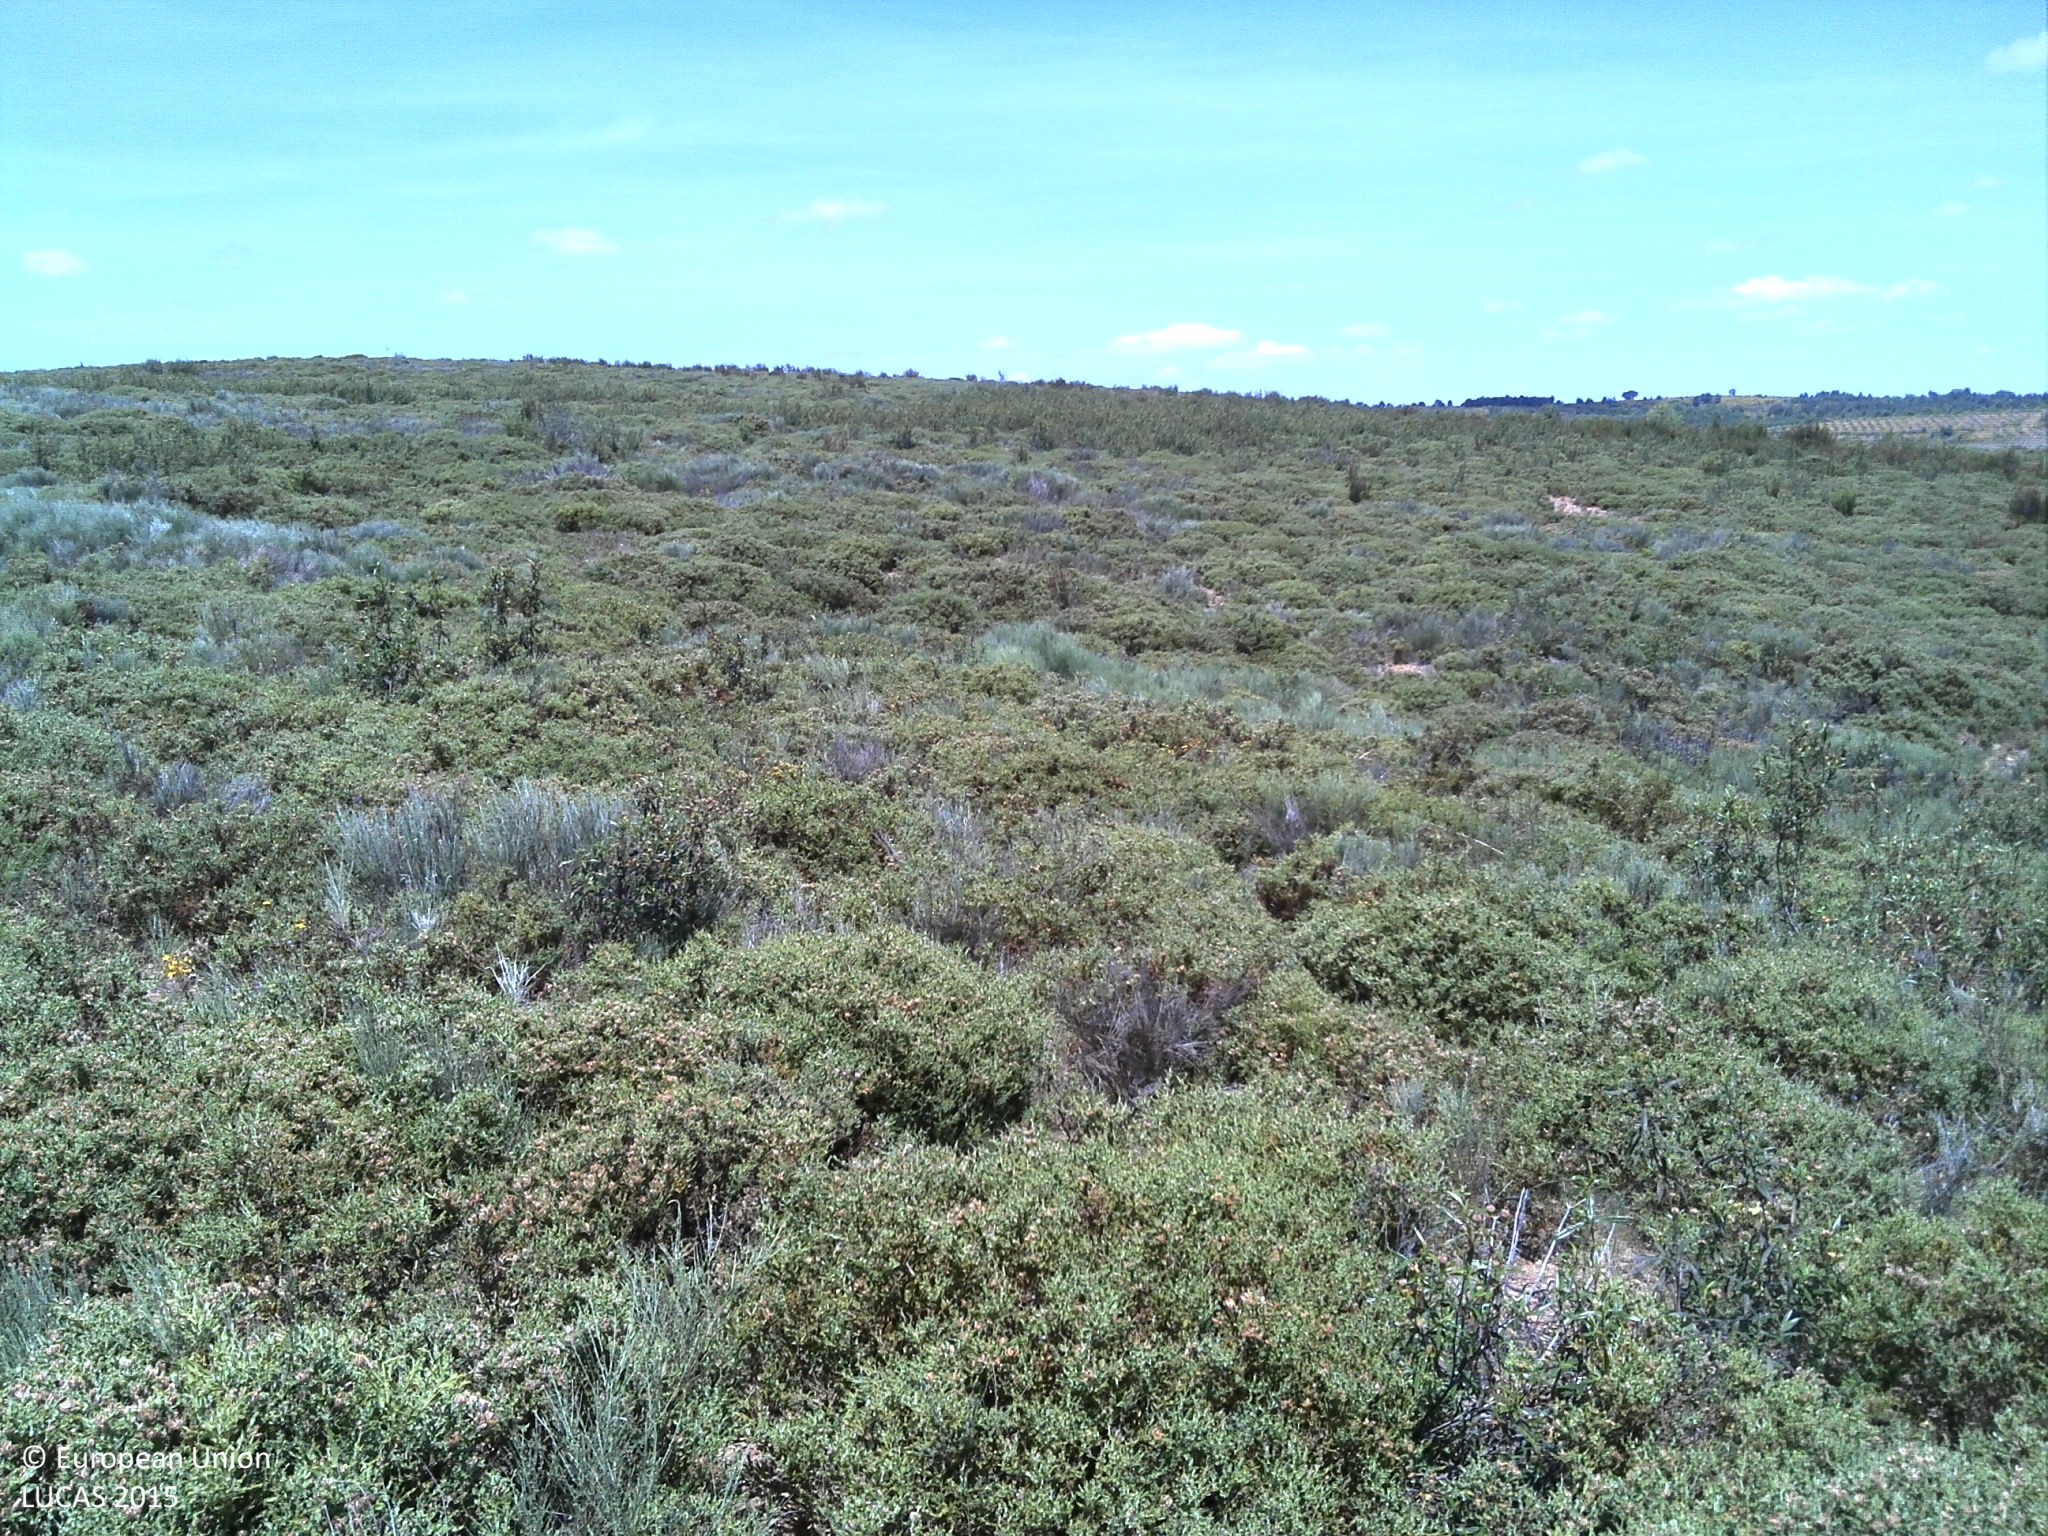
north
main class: Shrubland
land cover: Shrubland without tree cover
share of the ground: > 75 %
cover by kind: shrubs 80 %, unconsolidated bare surface 20 %
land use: Abandoned areas
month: May
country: PT
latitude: 41.1624
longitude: -6.9236
